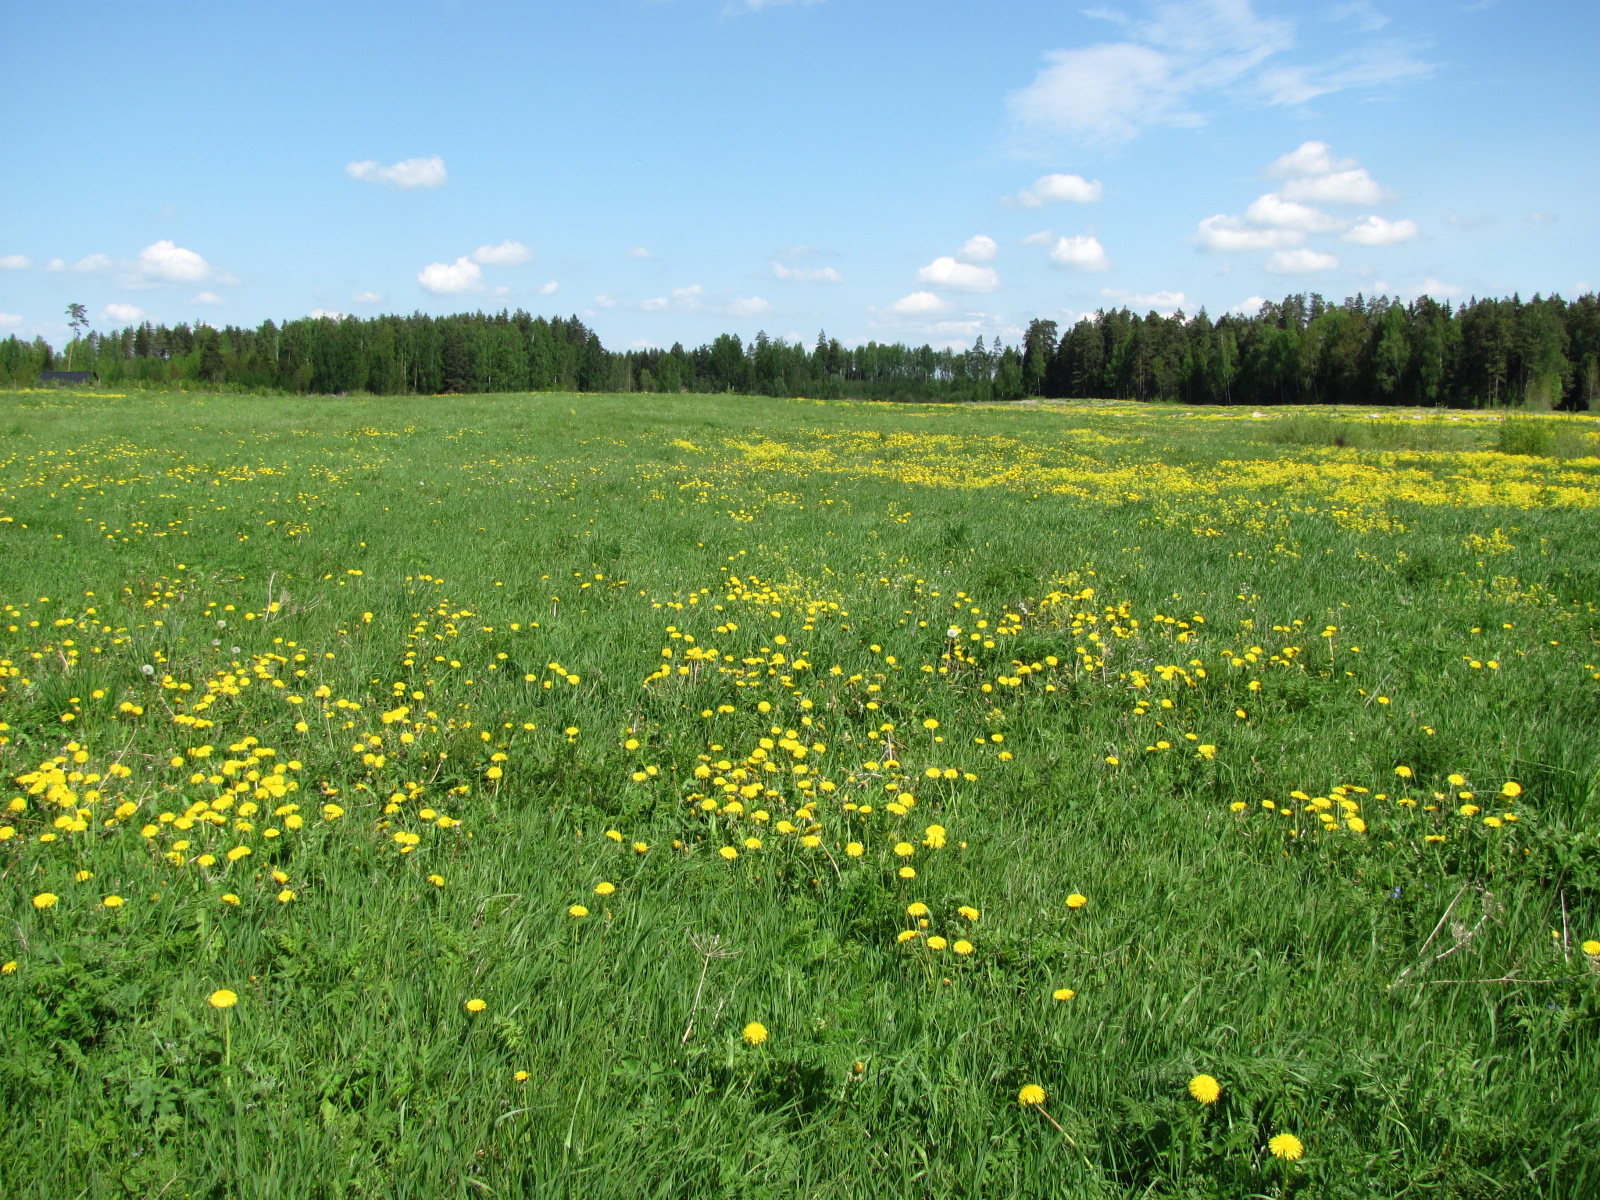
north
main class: Grassland
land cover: Grassland without tree/shrub cover
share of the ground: > 75 %
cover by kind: herbaceous plants 100 %
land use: Agriculture (excluding fallow land and kitchen gardens)
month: May
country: LV
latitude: 56.7951
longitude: 24.4190
